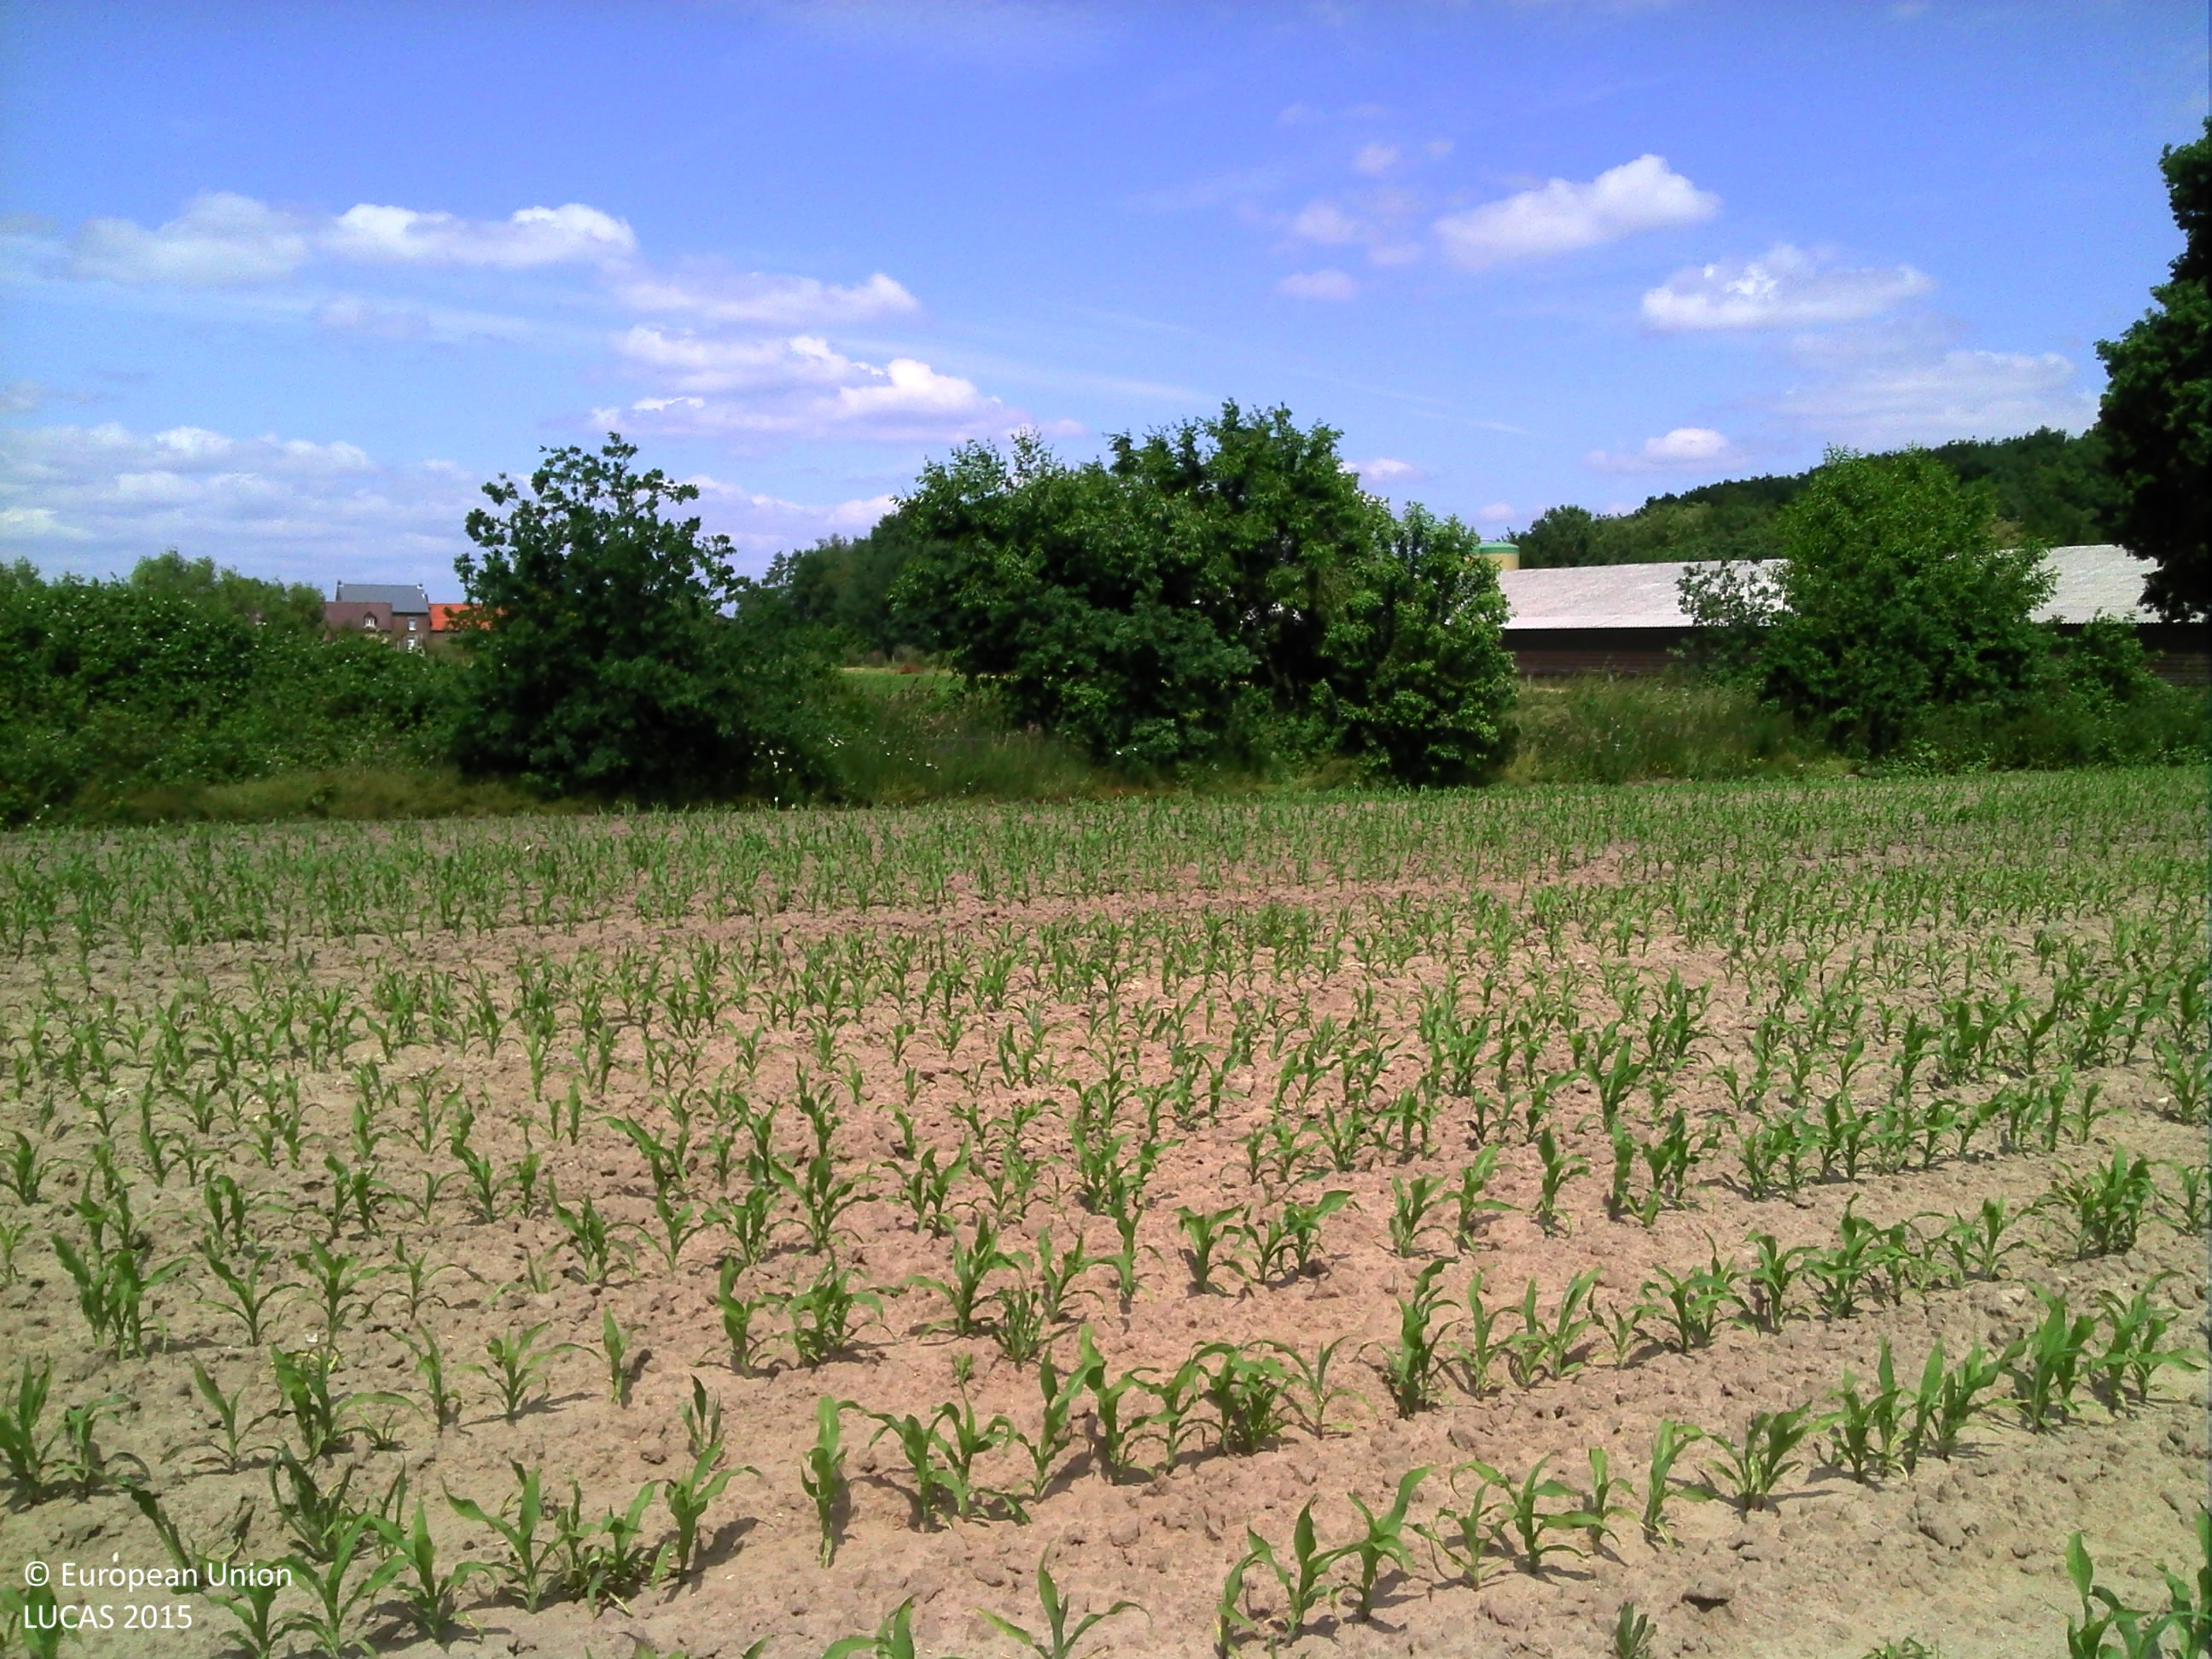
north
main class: Cropland
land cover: Maize
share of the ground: 10 - 25 %
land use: Agriculture (excluding fallow land and kitchen gardens)
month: June
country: BE
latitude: 51.1136
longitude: 5.7560
